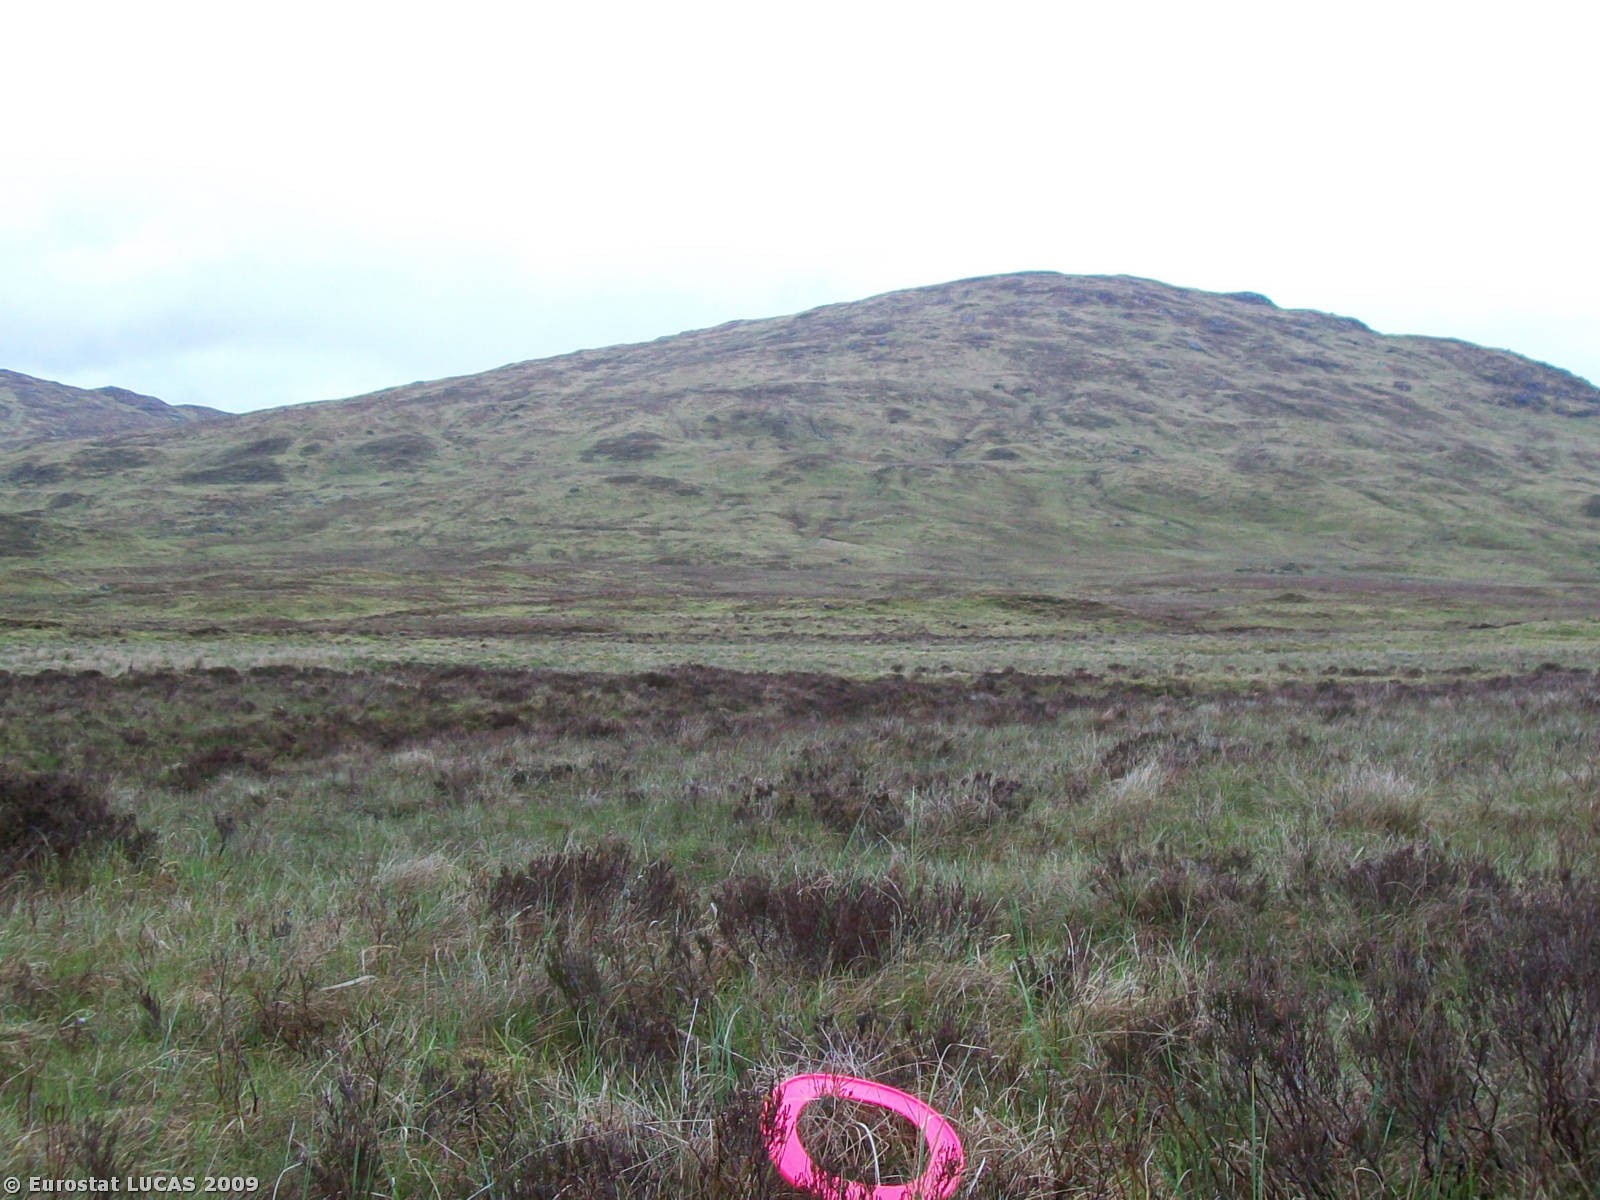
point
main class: Shrubland
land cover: Shrubland without tree cover
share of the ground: > 75 %
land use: Nature reserves
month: May
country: GB
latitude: 56.5723
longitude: -4.7667
